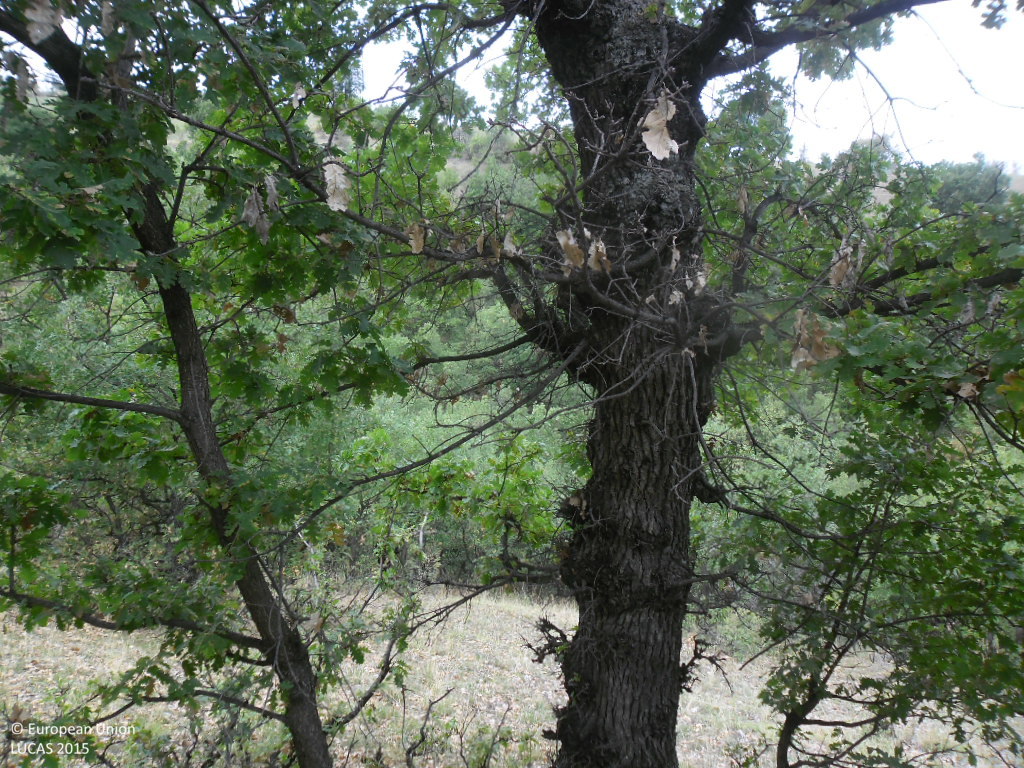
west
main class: Woodland
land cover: Broadleaved woodland
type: thermophilous deciduous forest
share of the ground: > 75 %
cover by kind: broadleaved forest trees 95 %, unconsolidated bare surface 5 %
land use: Forestry
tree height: < 5 m
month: September
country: BG
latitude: 41.6053
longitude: 23.1839
